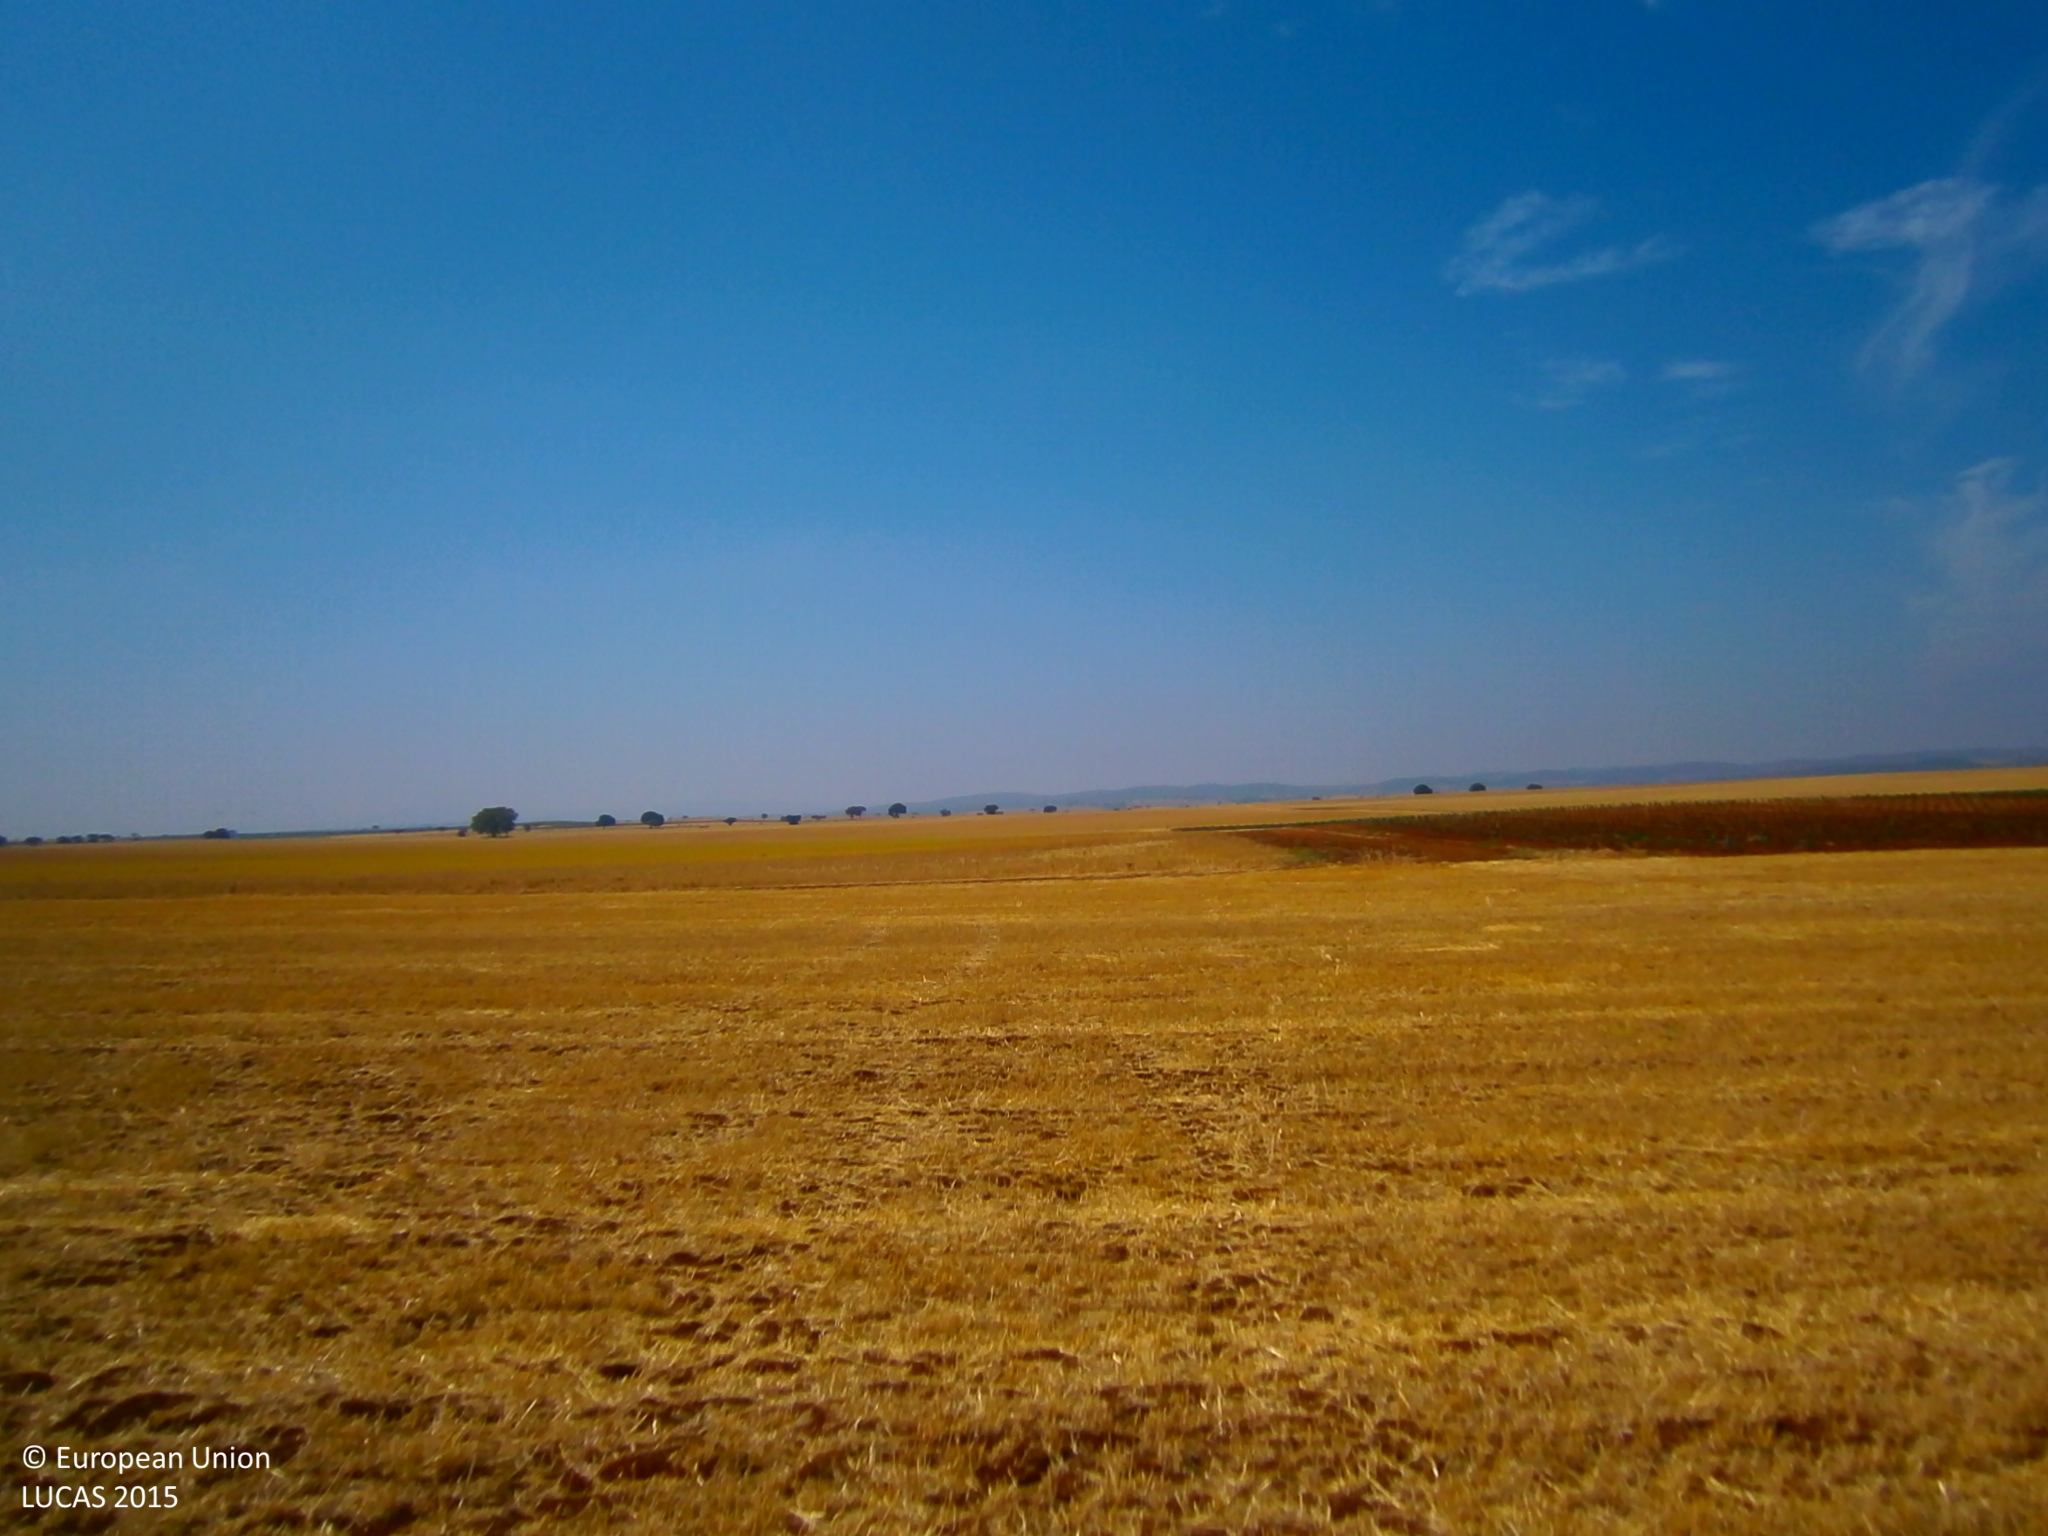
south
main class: Cropland
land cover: Barley
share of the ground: > 75 %
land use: Agriculture (excluding fallow land and kitchen gardens)
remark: Harvested field
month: July
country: ES
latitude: 38.7483
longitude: -6.9227
